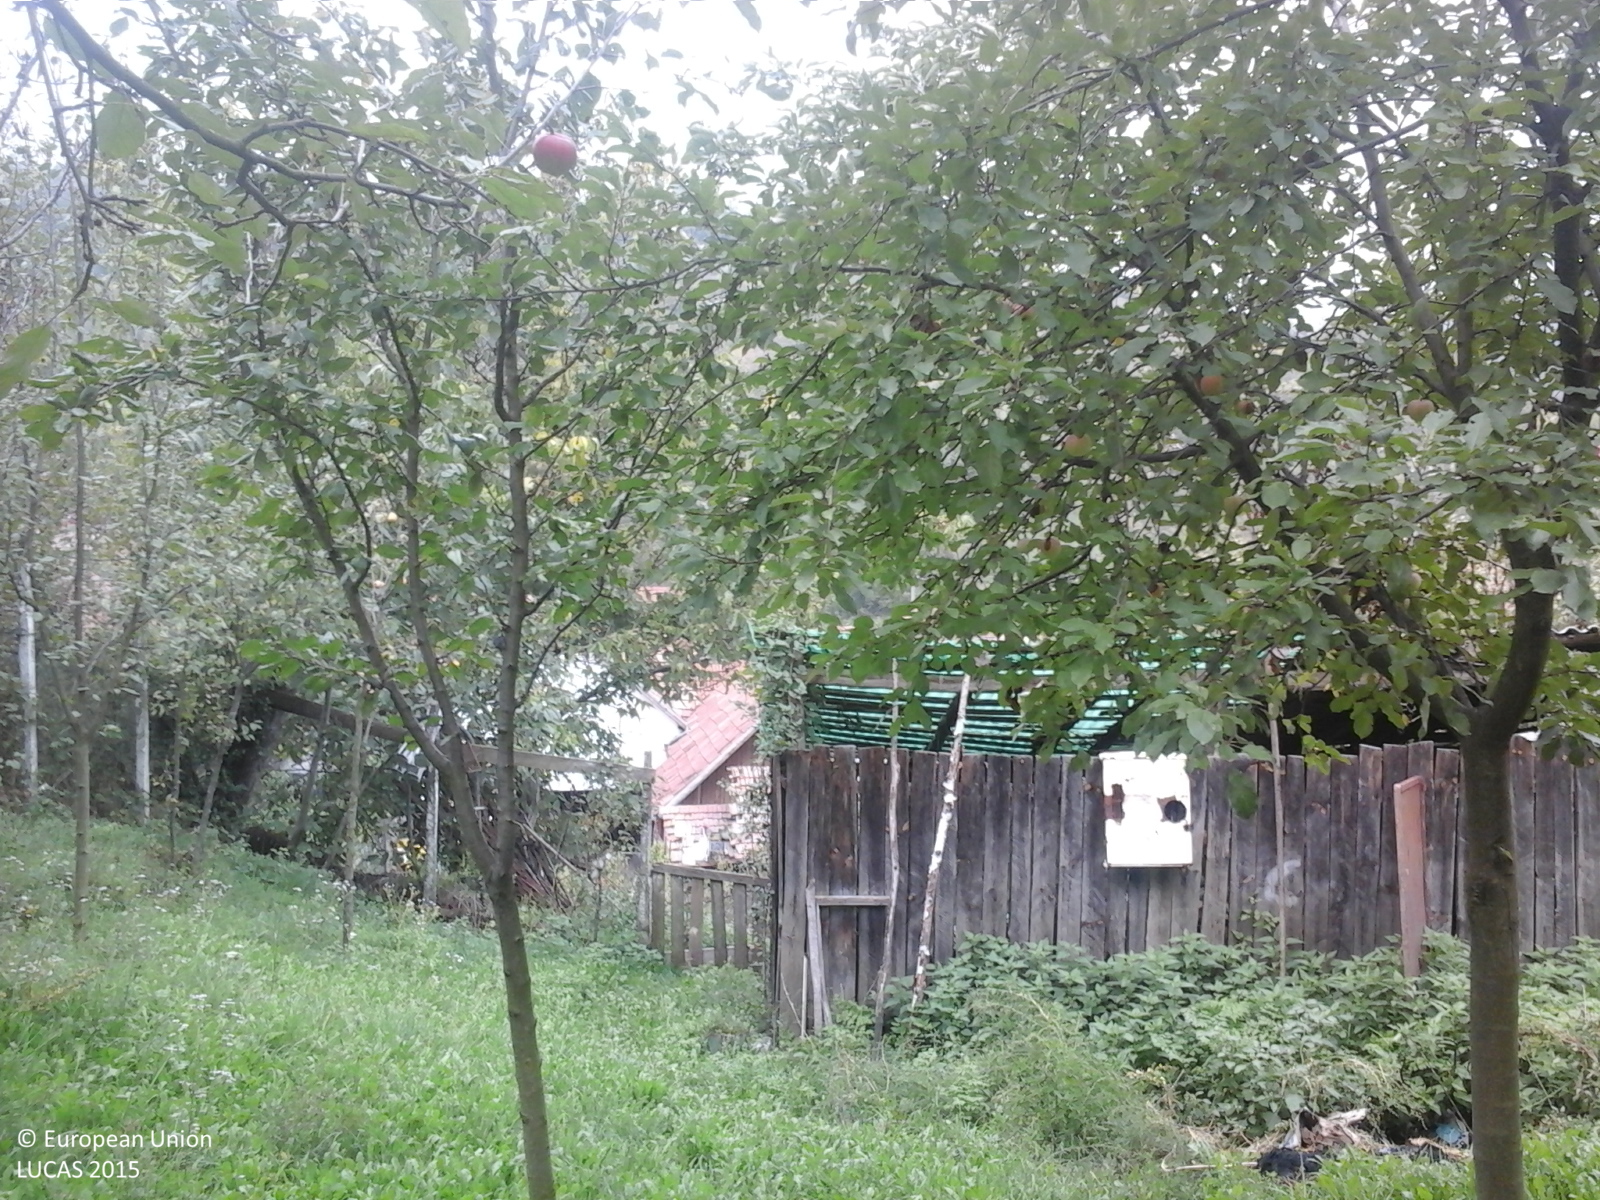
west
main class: Cropland
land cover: Nuts trees
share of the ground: > 75 %
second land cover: Grassland without tree/shrub cover
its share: > 75 %
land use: Agriculture (excluding fallow land and kitchen gardens)
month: October
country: RO
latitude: 46.1665
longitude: 23.4960
